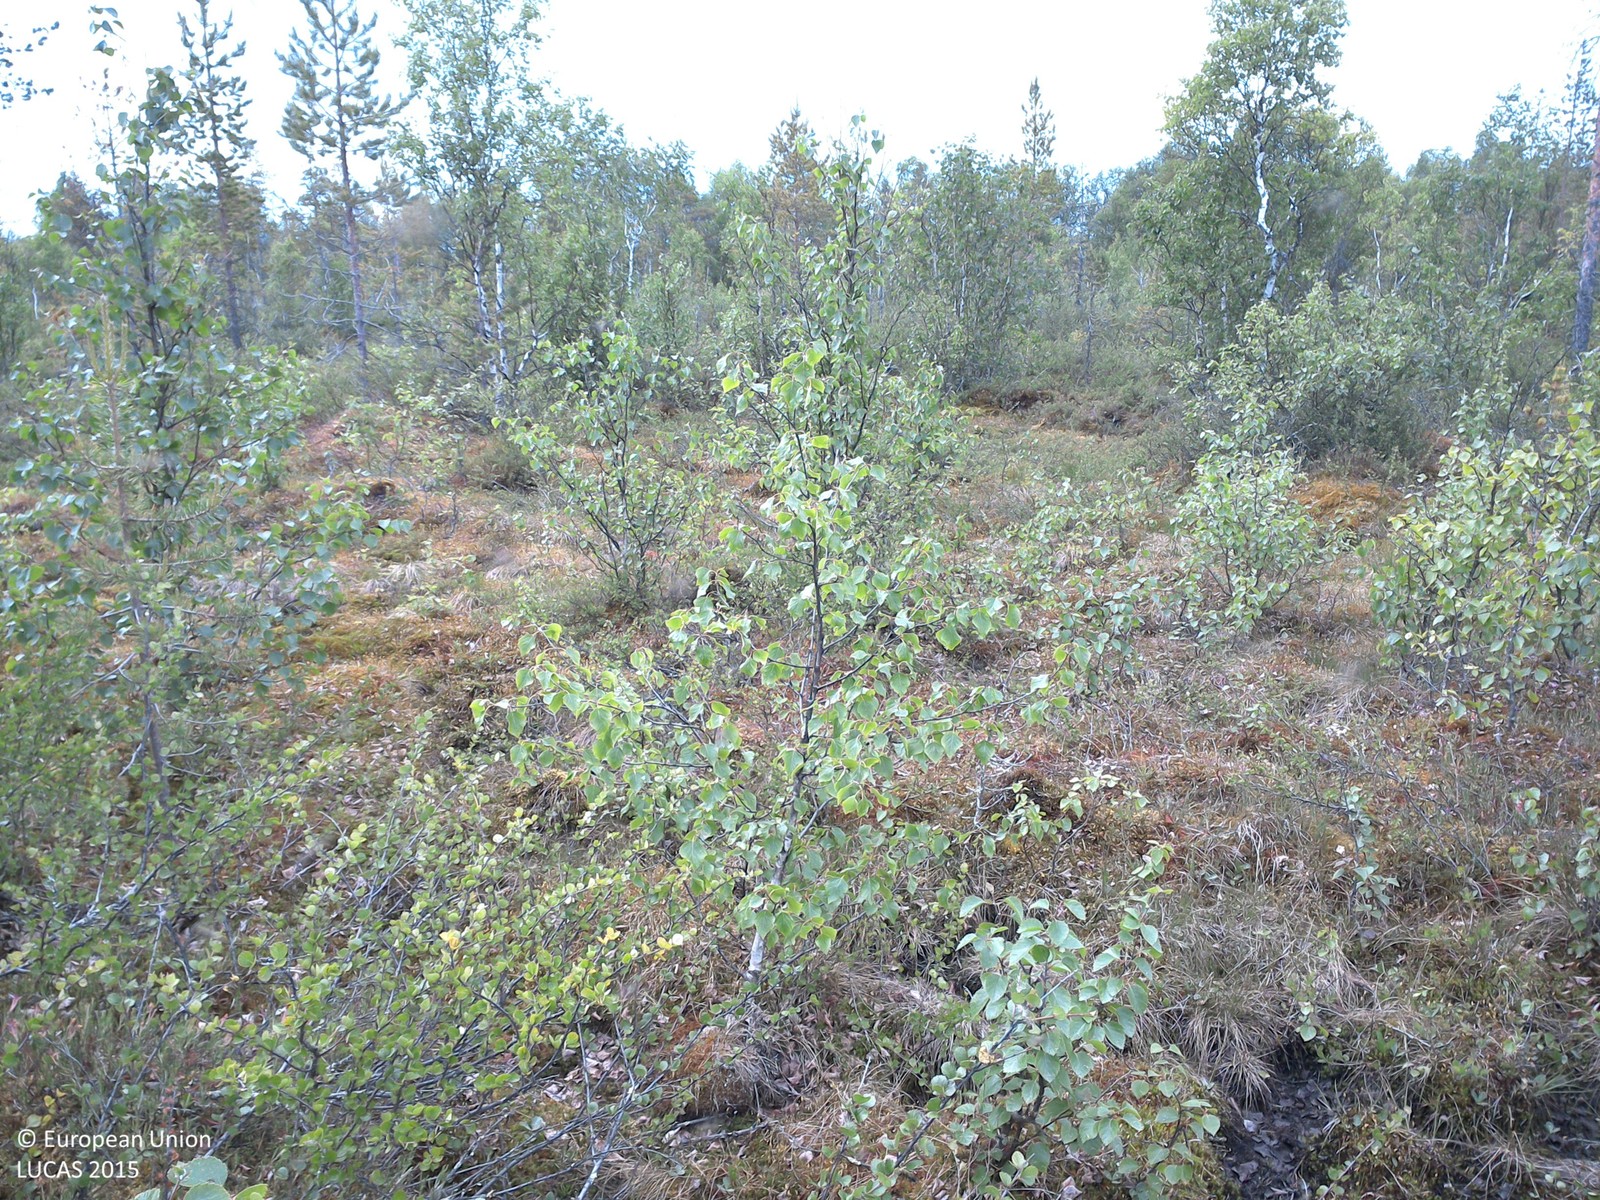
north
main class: Woodland
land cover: Other mixed woodland
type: boreal forest
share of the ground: 10 - 25 %
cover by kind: lichens and mosses 45 %, shrubs 35 %, coniferous forest trees 10 %, broadleaved forest trees 10 %
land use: Forestry
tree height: < 5 m
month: July
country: SE
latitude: 67.2439
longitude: 23.2444
